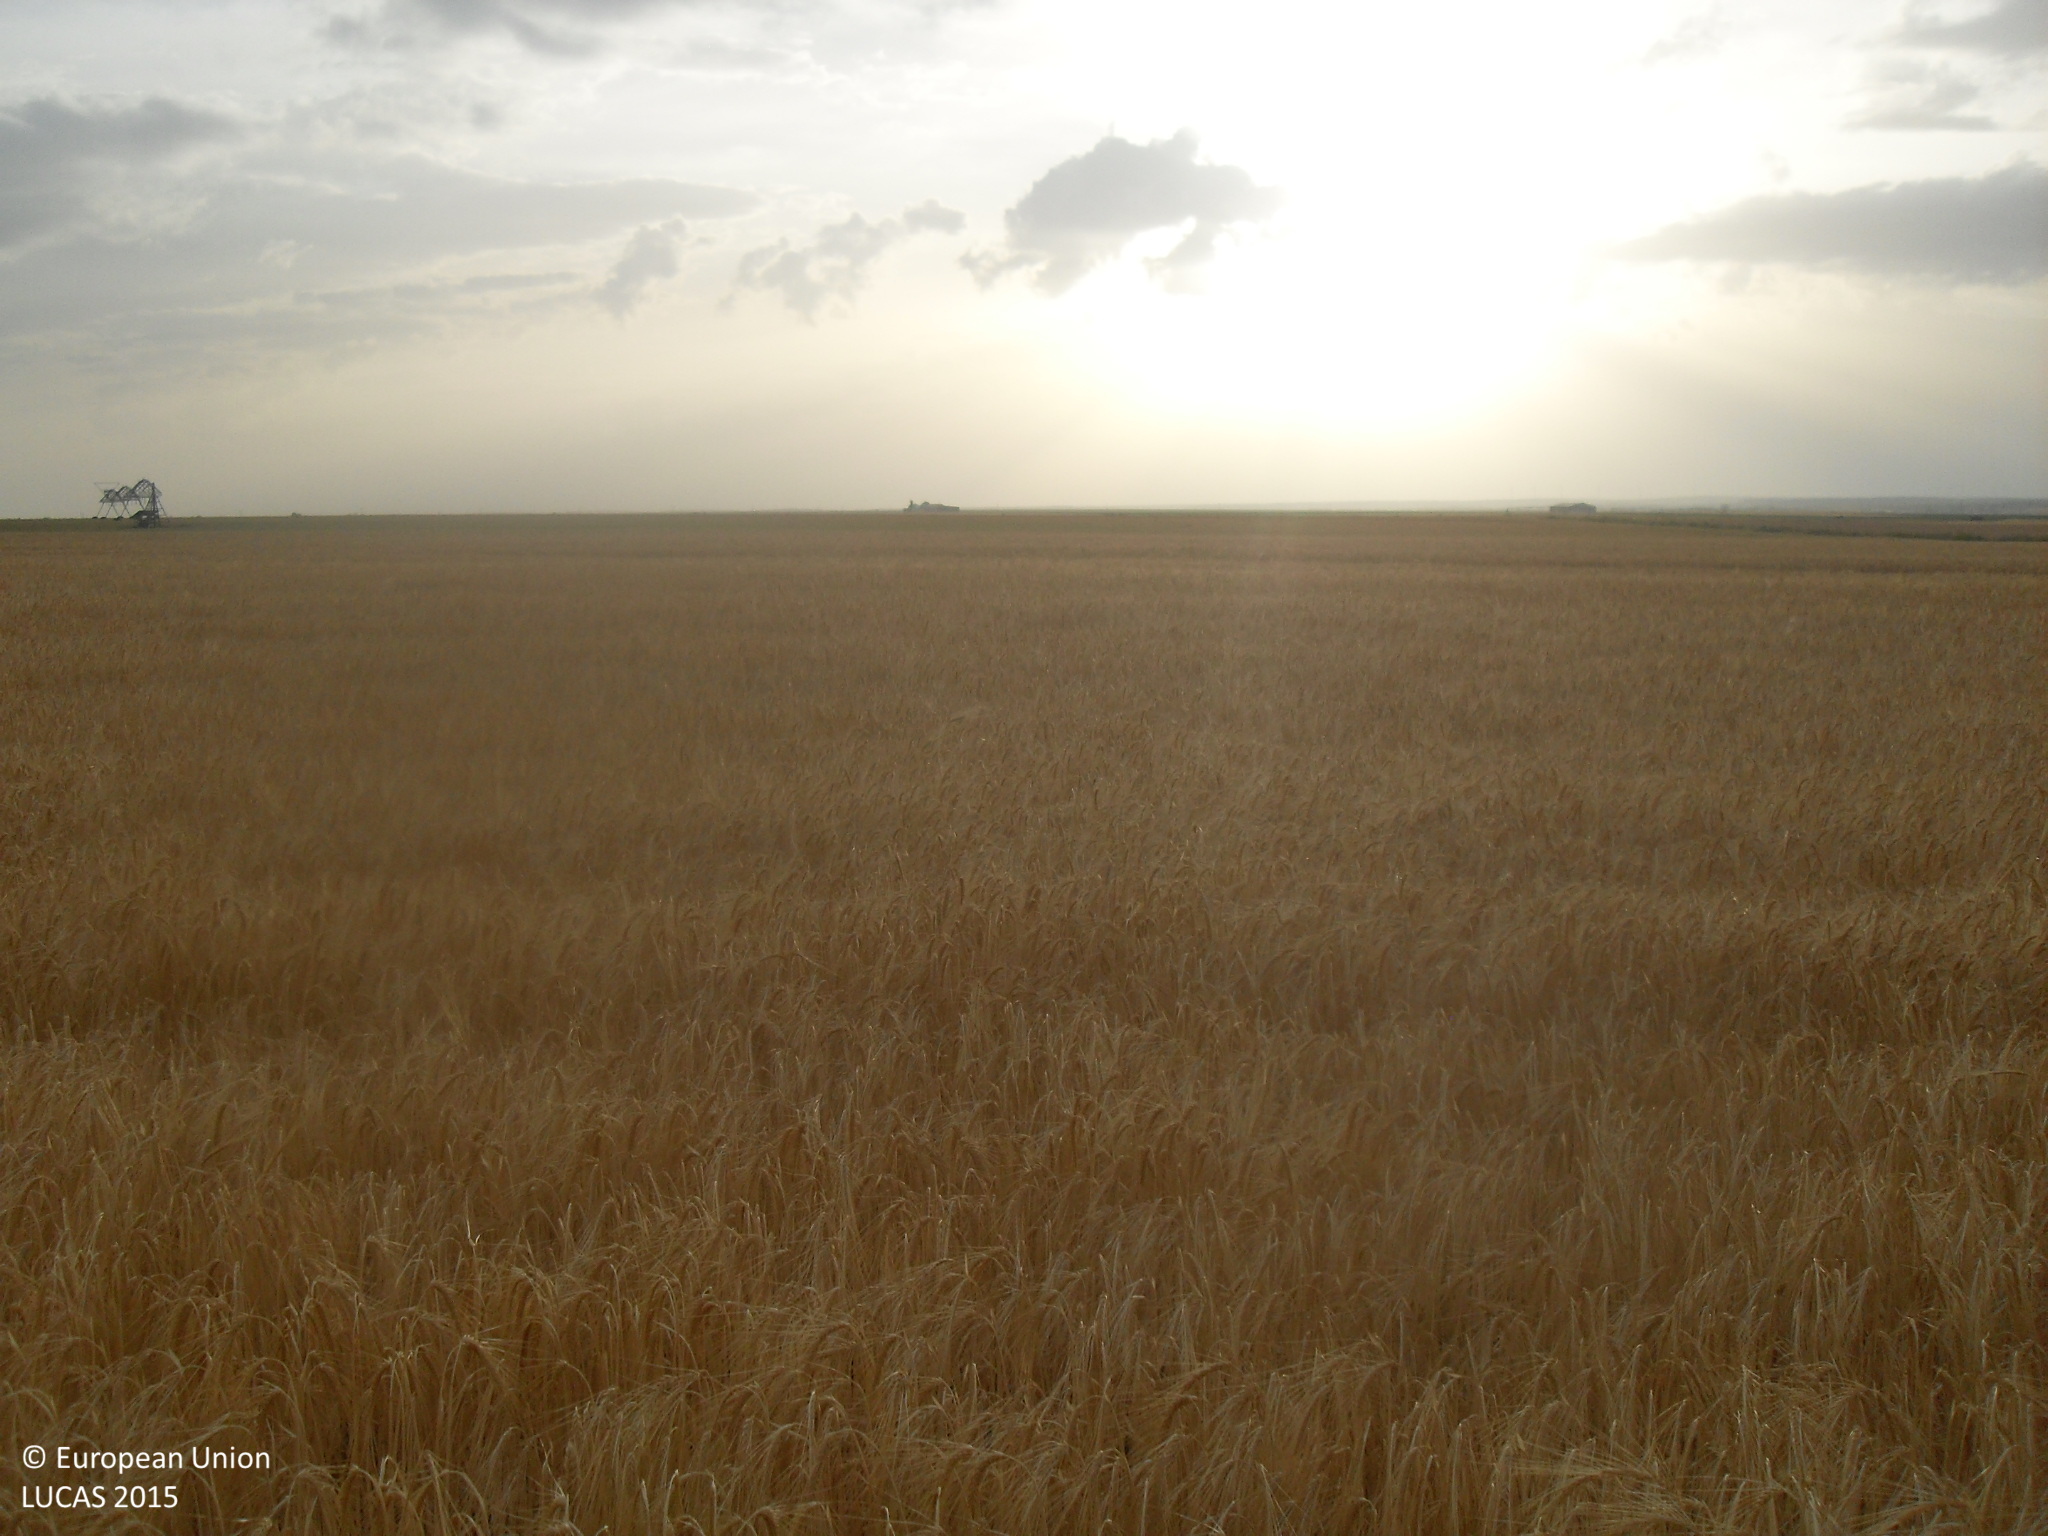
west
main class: Cropland
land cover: Barley
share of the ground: > 75 %
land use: Agriculture (excluding fallow land and kitchen gardens)
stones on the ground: 10 - 25 %
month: June
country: ES
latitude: 41.0708
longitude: -5.7059
